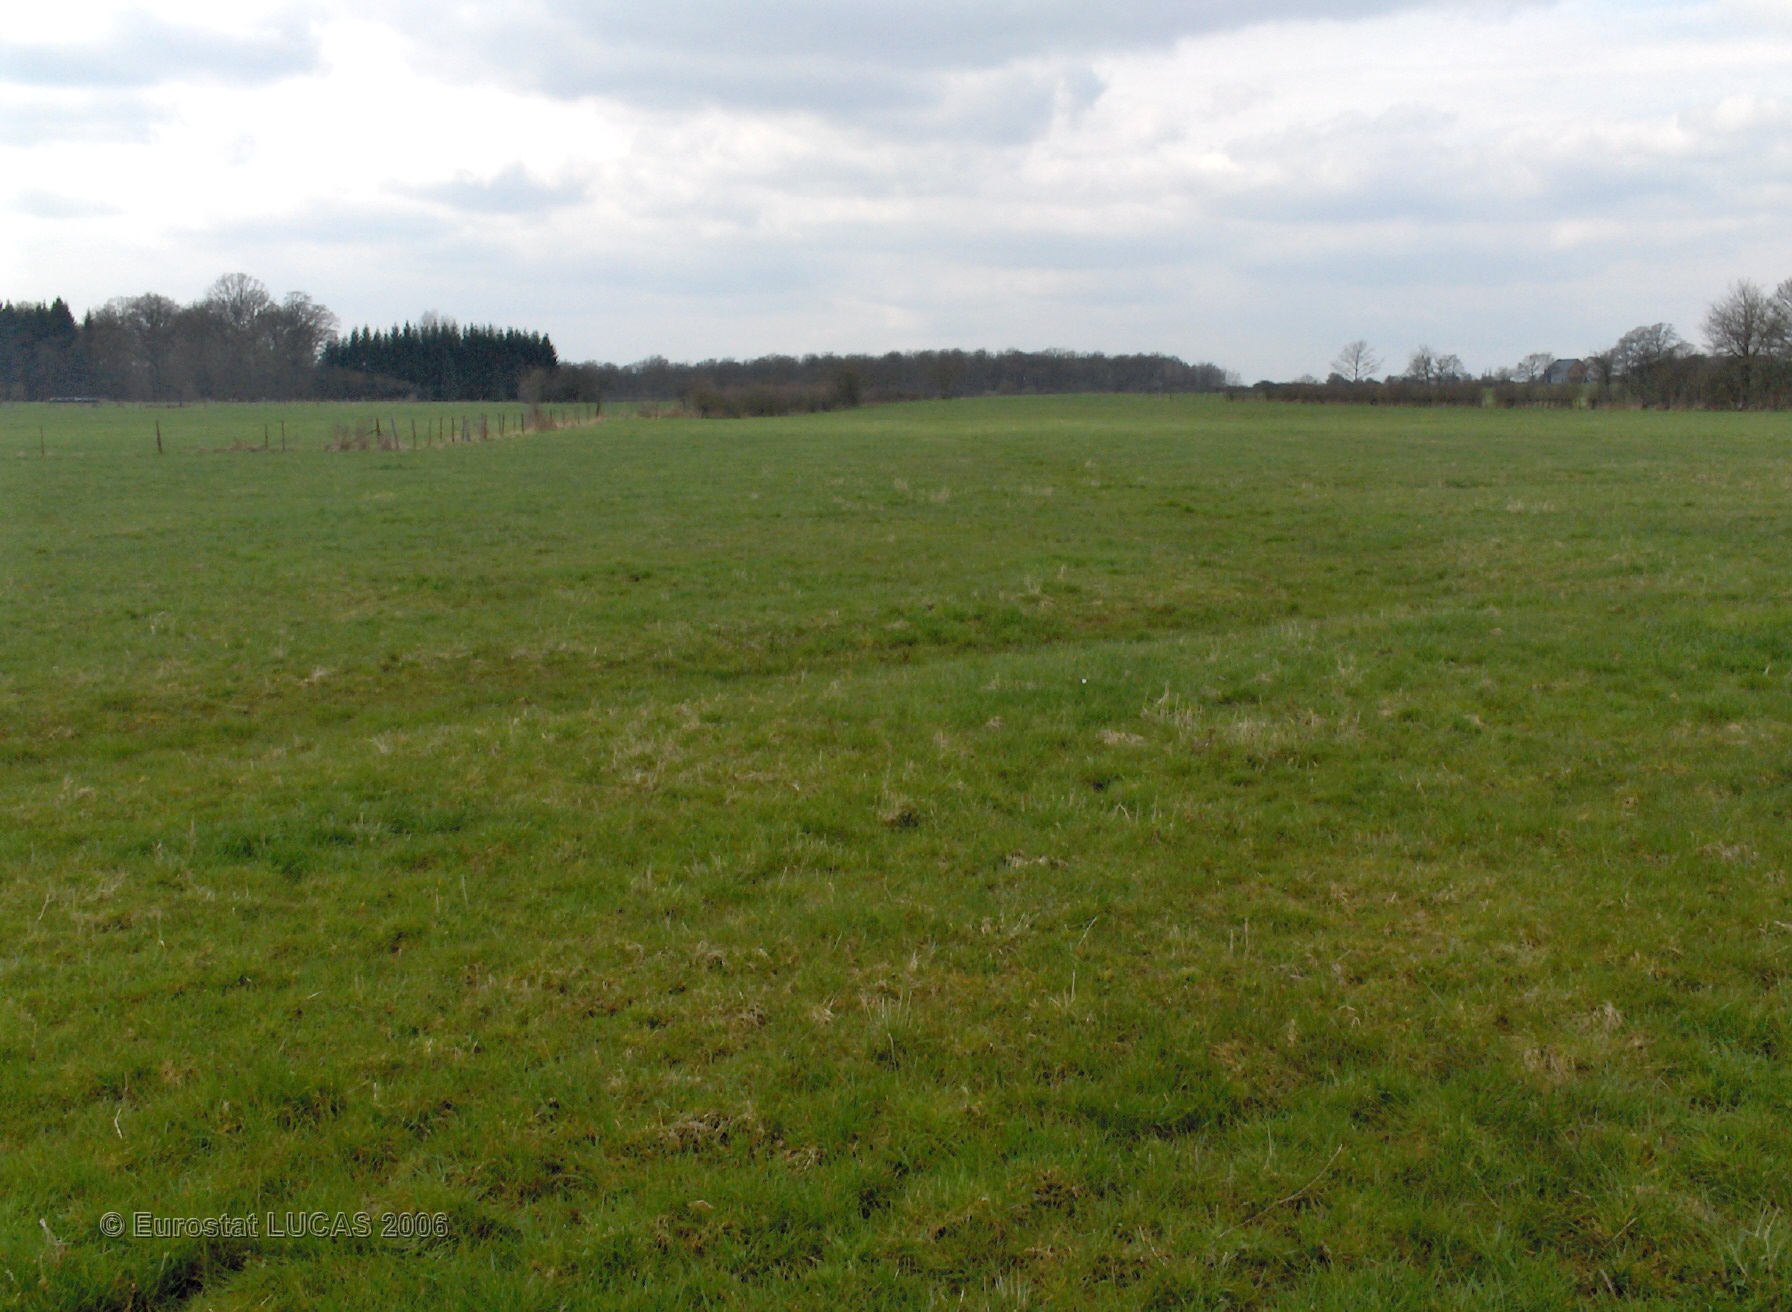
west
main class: Grassland
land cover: Grassland without tree/shrub cover
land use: Agriculture (excluding fallow land and kitchen gardens)
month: April
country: BE
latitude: 50.1263
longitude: 4.5548
